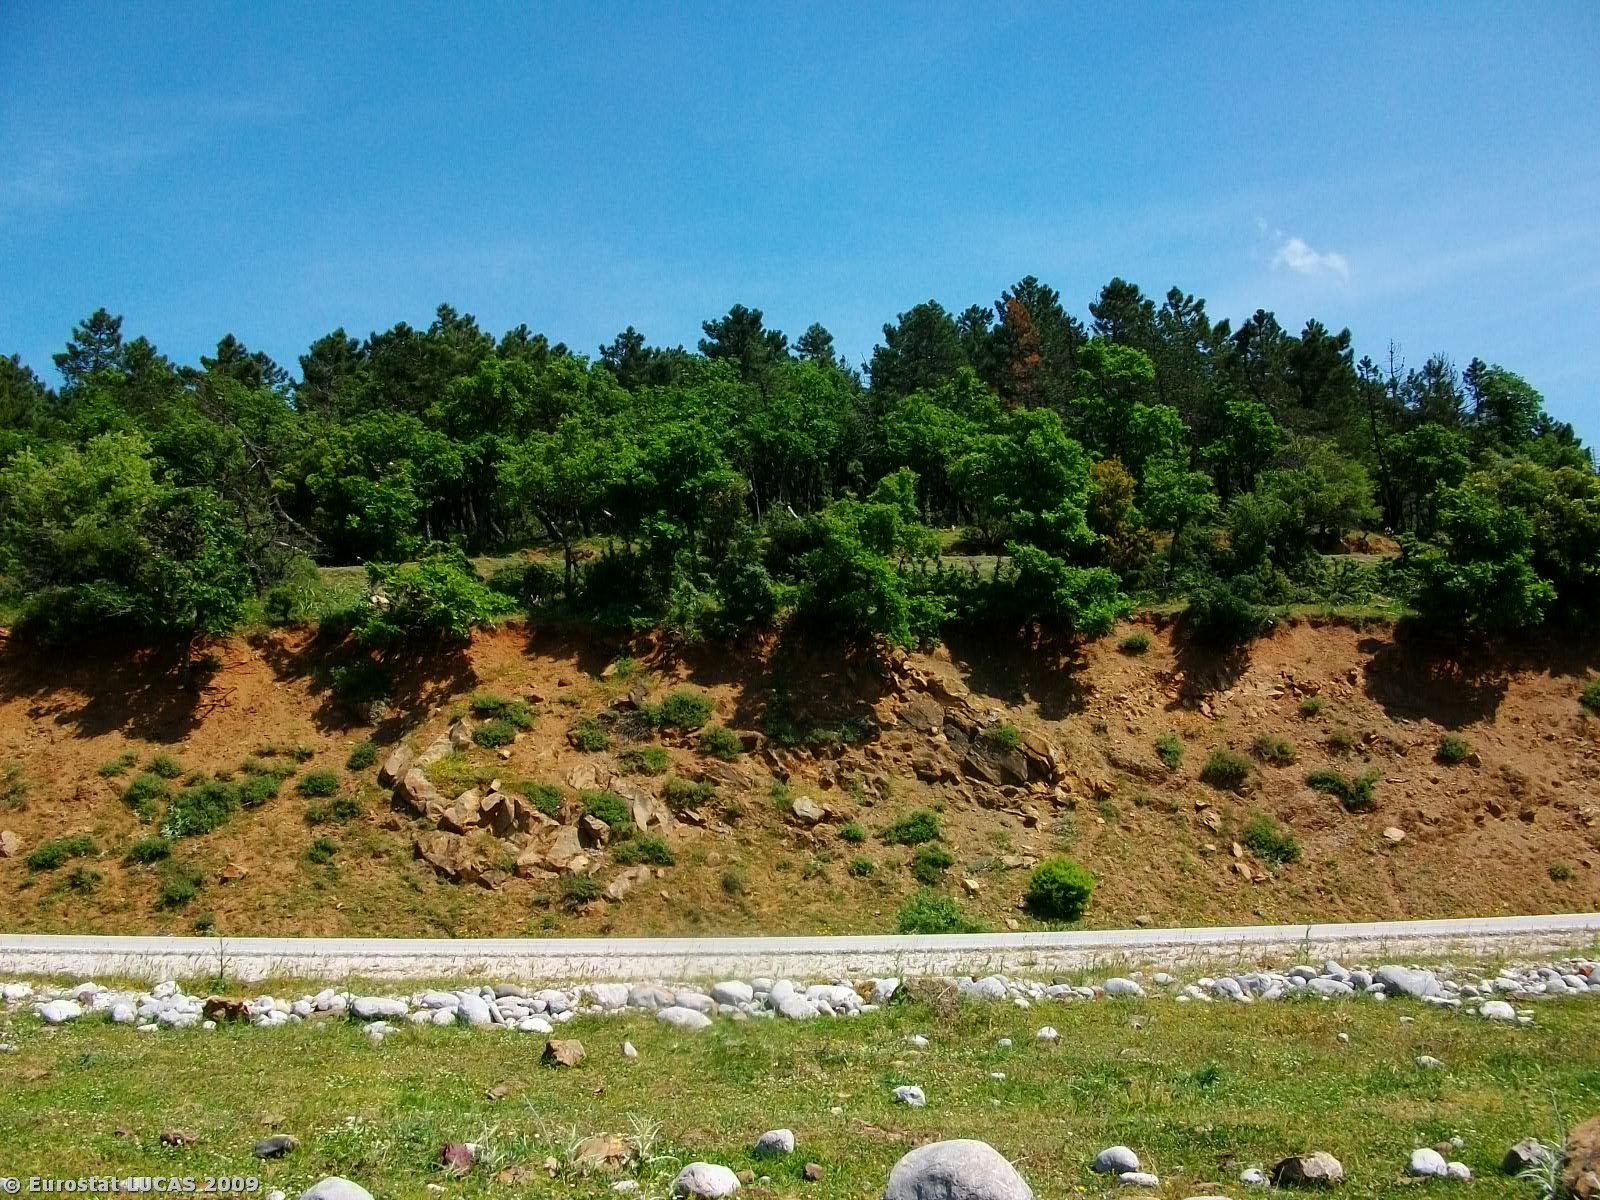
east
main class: Woodland
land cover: Broadleaved woodland
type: acidophilous oak and oak-birch forest
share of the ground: > 75 %
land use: Forestry
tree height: > 5 m
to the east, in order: Broadleaved woodland; Grassland without tree/shrub cover; Paved roads, cycling and walking lanes; Broadleaved woodland; Tracks; Mixed woodland
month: May
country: GR
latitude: 39.1633
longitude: 22.5654
